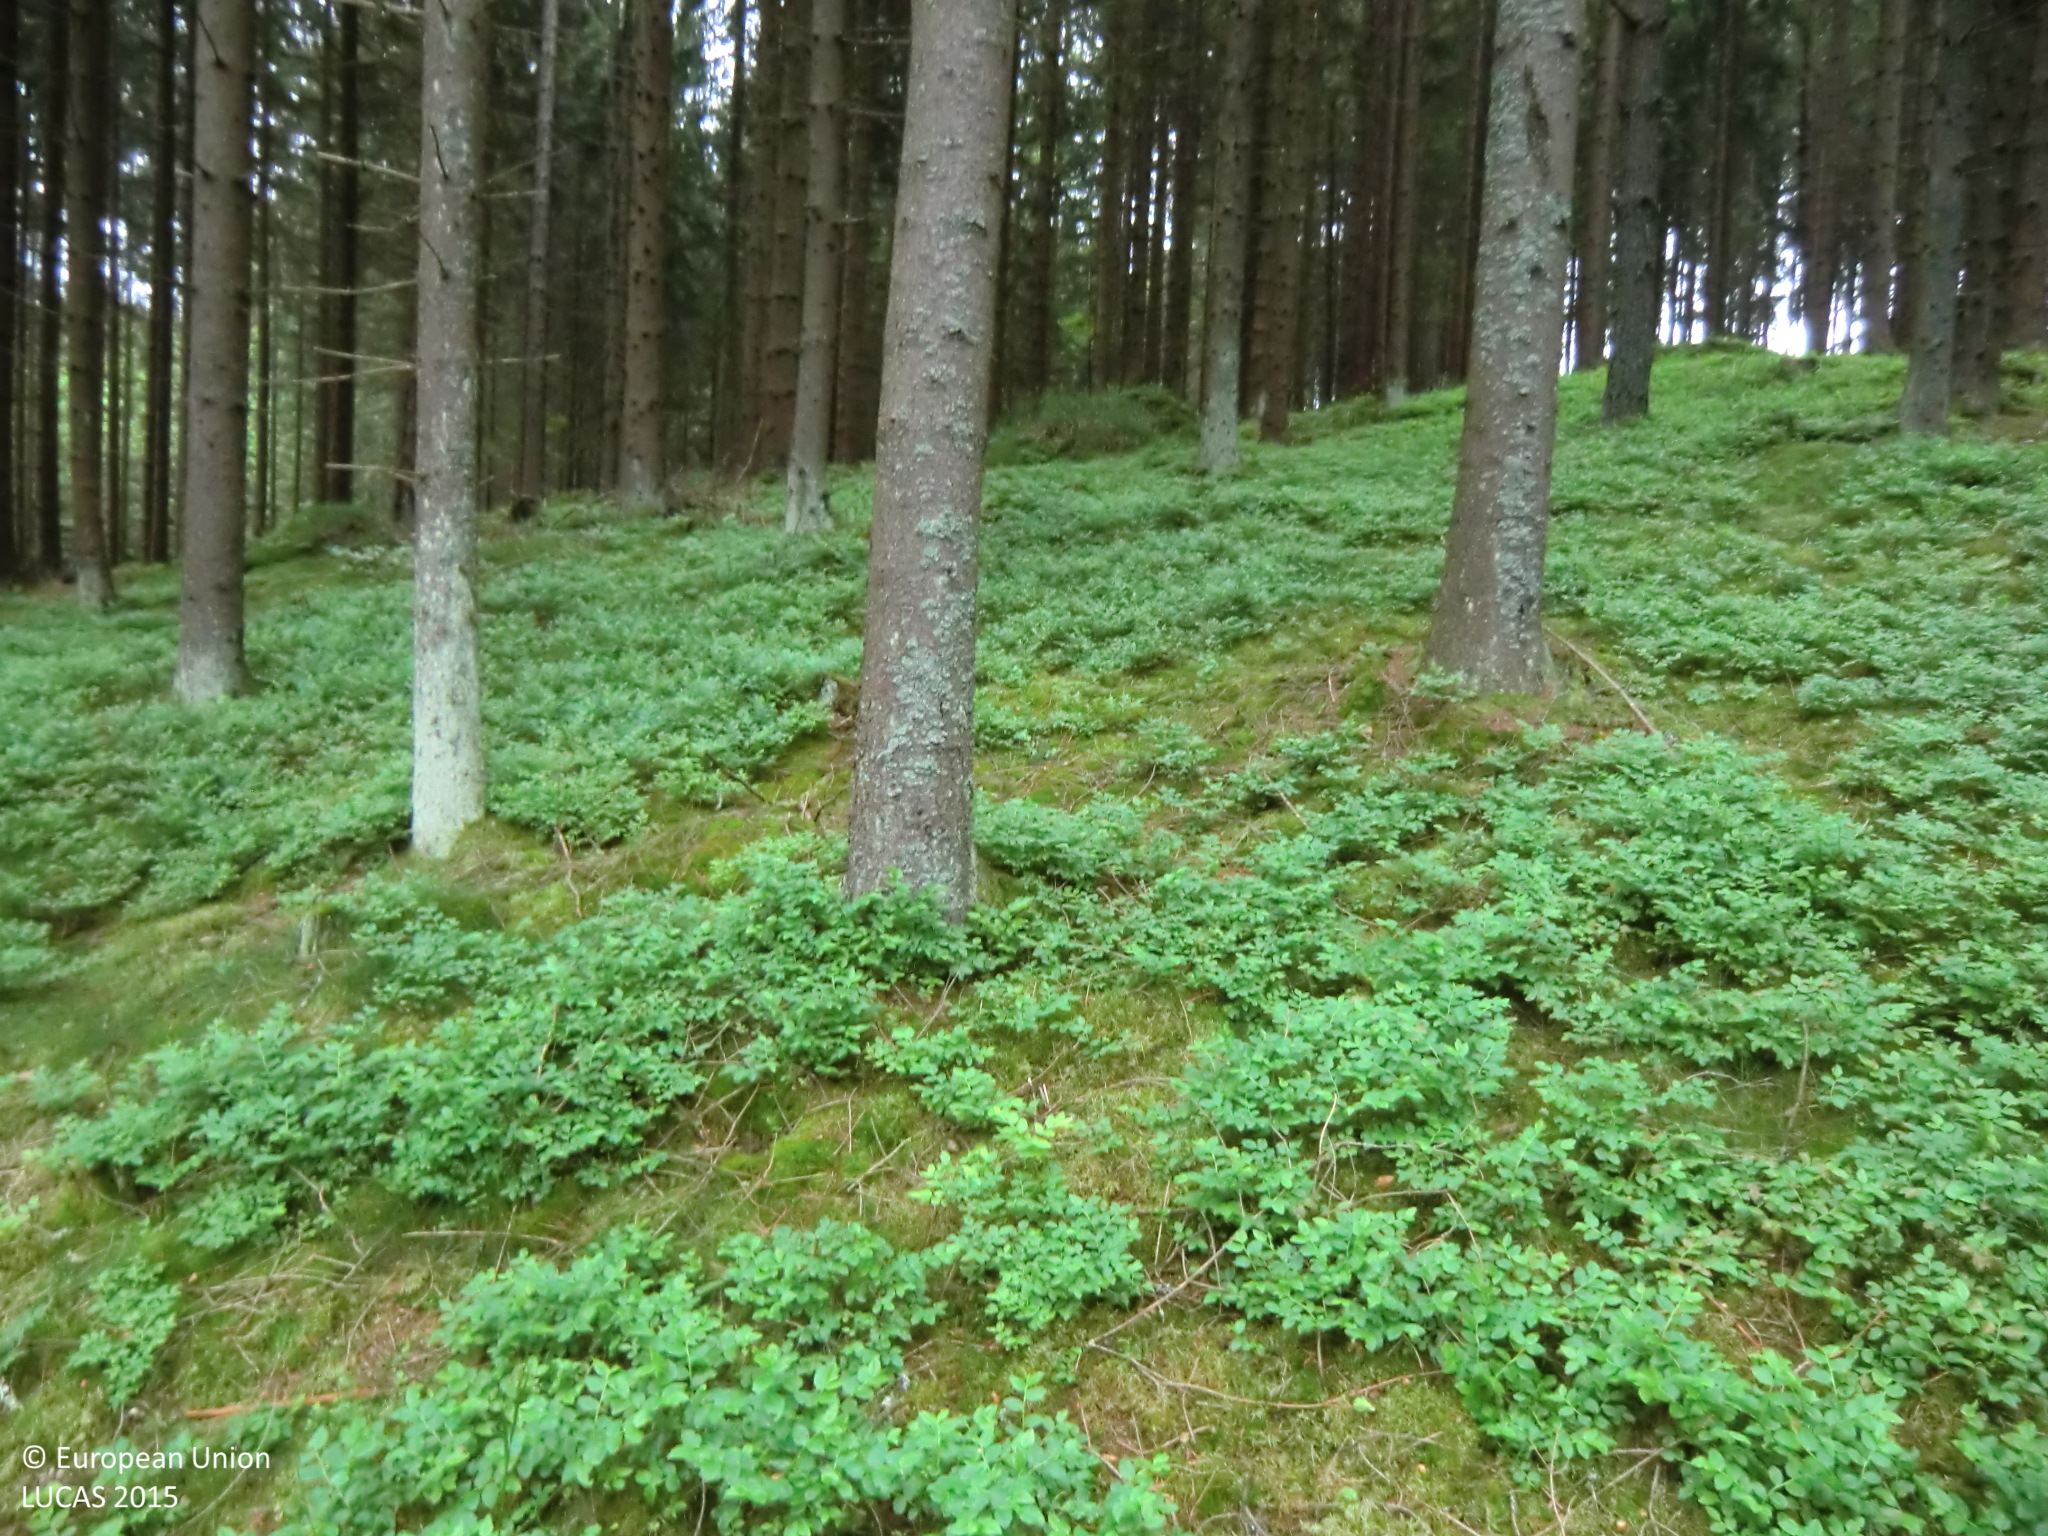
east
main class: Woodland
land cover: Spruce dominated coniferous woodland
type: hemiboreal forest and nemoral coniferous forest and mixed broadleaved-coniferous forest
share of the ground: > 75 %
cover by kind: coniferous forest trees 75 %, unconsolidated bare surface 15 %, shrubs 5 %, herbaceous plants 5 %
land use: Forestry
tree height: > 5 m
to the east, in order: Spruce dominated coniferous woodland; Tracks; Spruce dominated coniferous woodland; Tracks; Spruce dominated coniferous woodland; Tracks; Spruce dominated coniferous woodland; Tracks; Grassland without tree/shrub cover; Rye
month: May
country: AT
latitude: 48.4052
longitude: 14.8507
